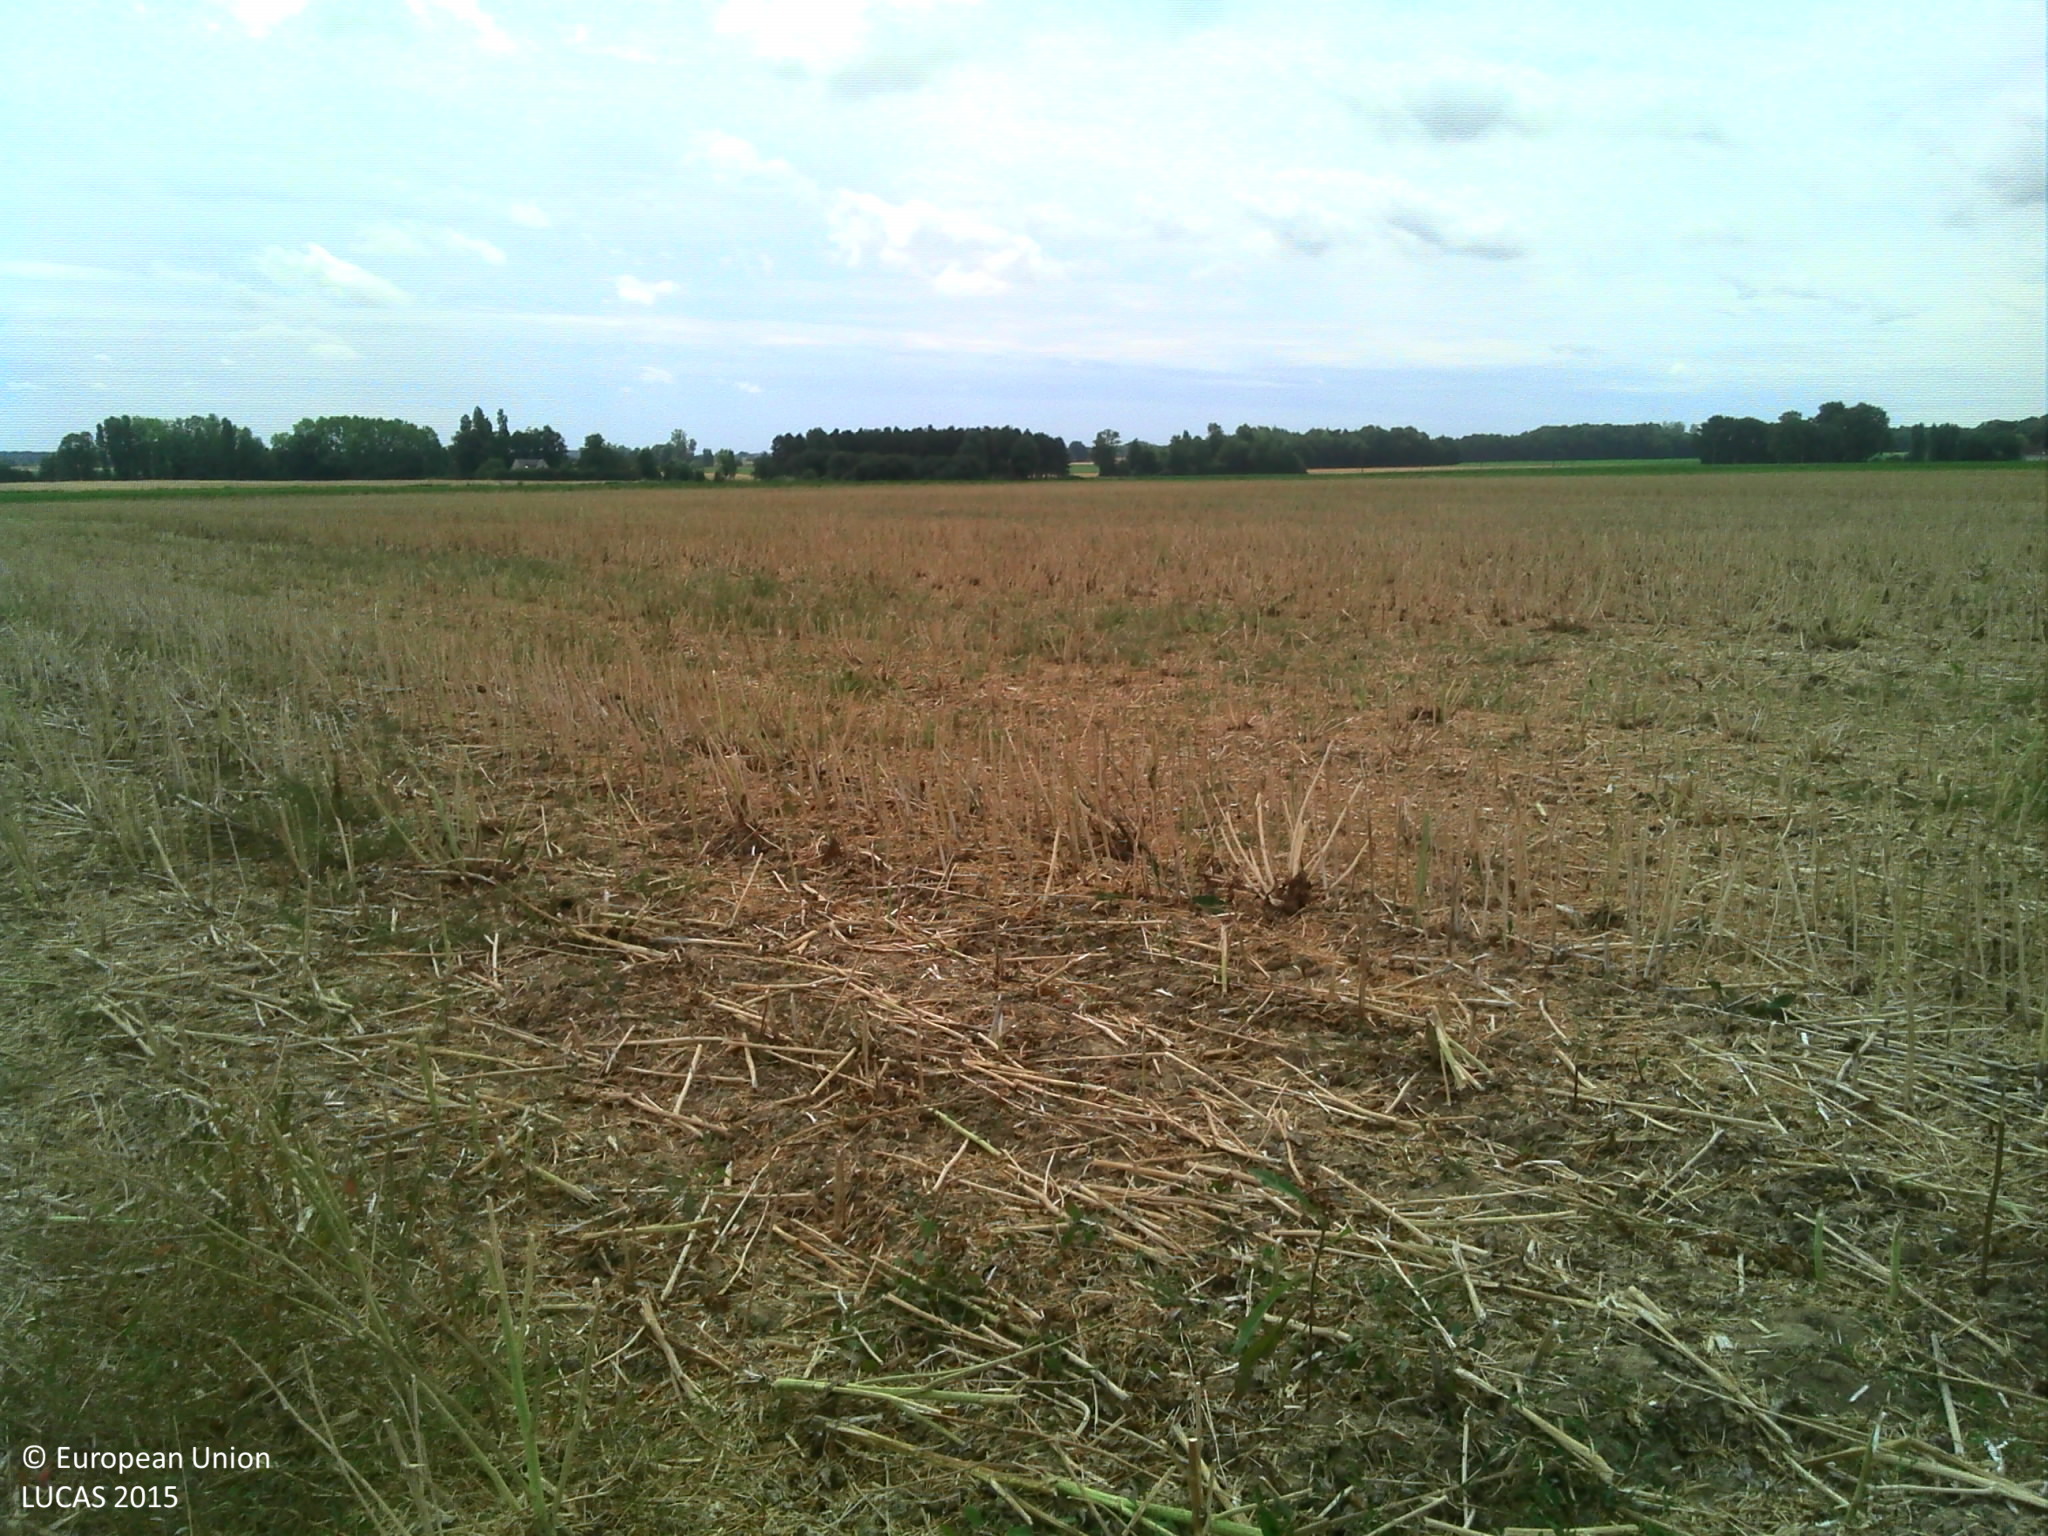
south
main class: Cropland
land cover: Rape and turnip rape
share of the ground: < 10 %
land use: Agriculture (excluding fallow land and kitchen gardens)
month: July
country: FR
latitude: 47.1468
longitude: 0.7642
